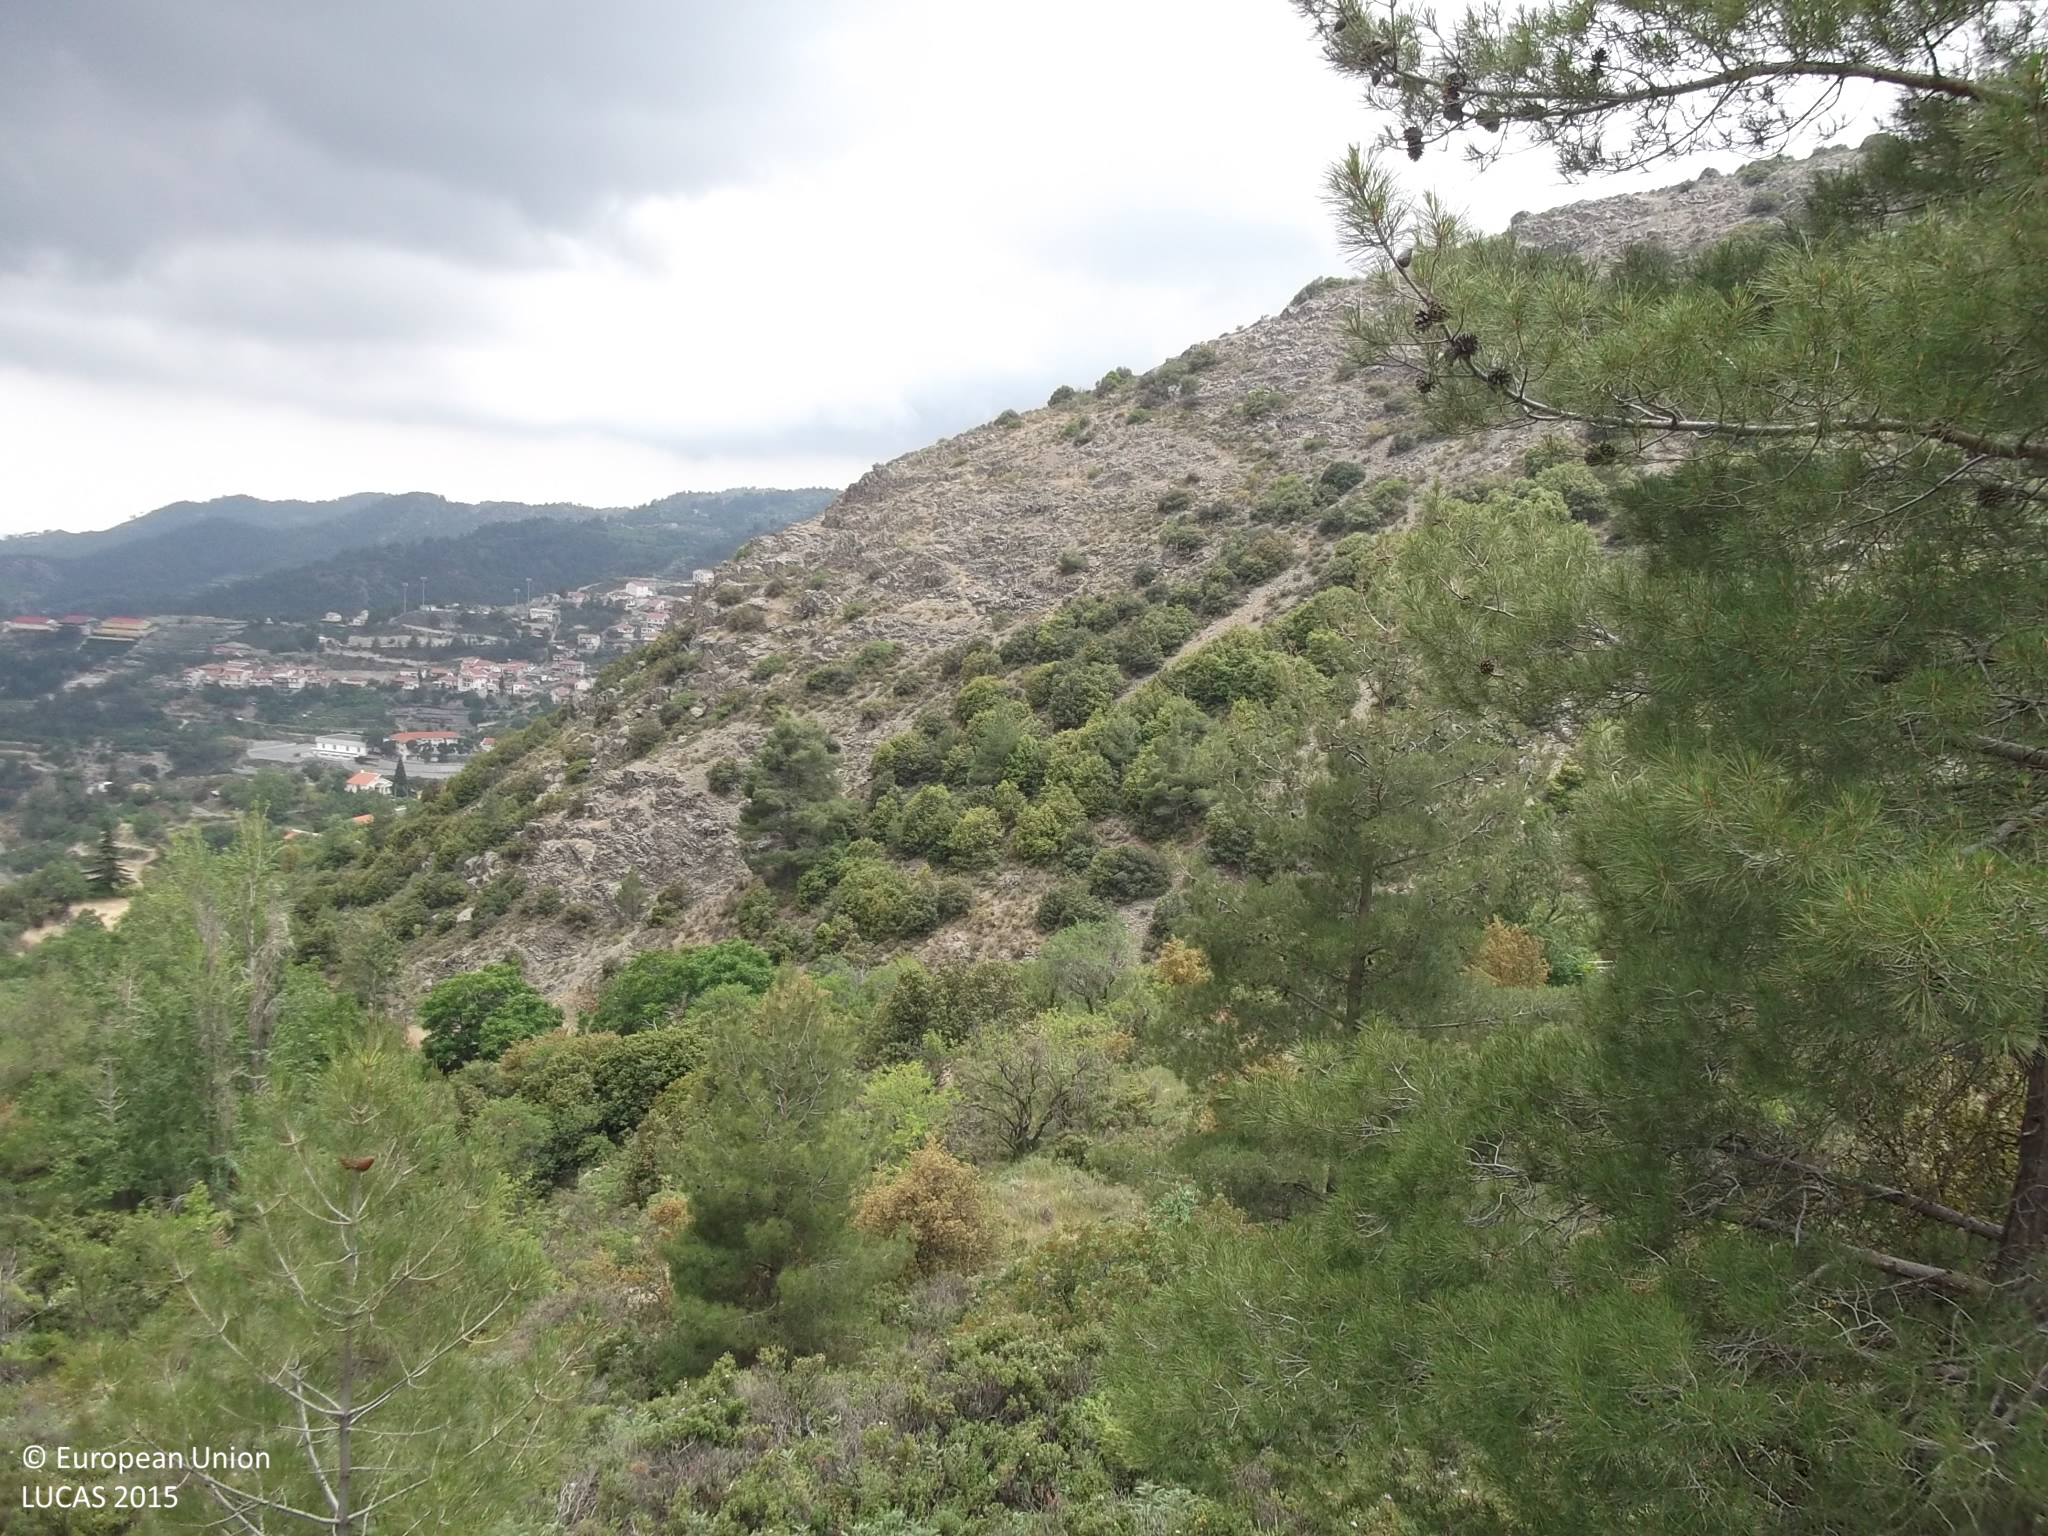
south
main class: Woodland
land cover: Pine dominated mixed woodland
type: coniferous forest of the mediterranean region
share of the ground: 25 - 50 %
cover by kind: coniferous forest trees 40 %, shrubs 35 %, broadleaved forest trees 15 %, unconsolidated bare surface 10 %
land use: Semi-natural and natural areas not in use
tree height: > 5 m
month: June
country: CY
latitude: 34.9490
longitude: 32.9802
